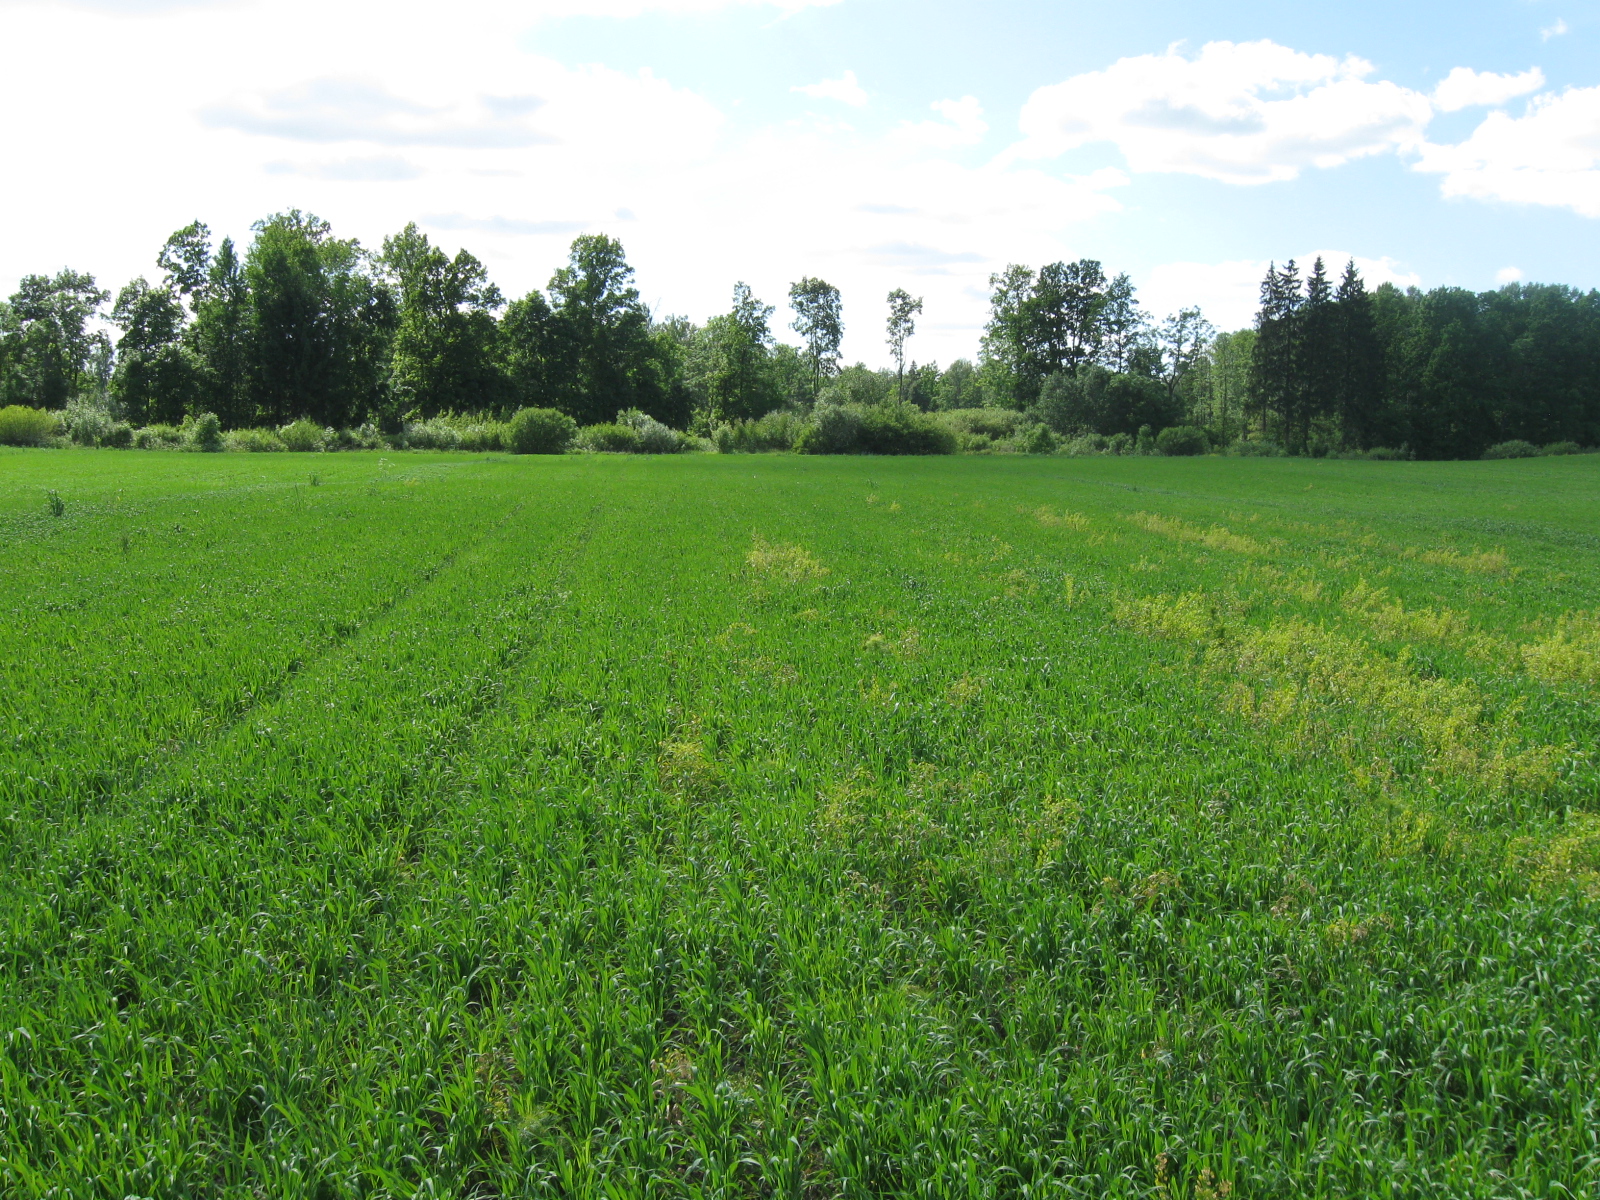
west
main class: Cropland
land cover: Oats
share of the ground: > 75 %
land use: Agriculture (excluding fallow land and kitchen gardens)
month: June
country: LT
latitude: 54.9674
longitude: 23.7535
